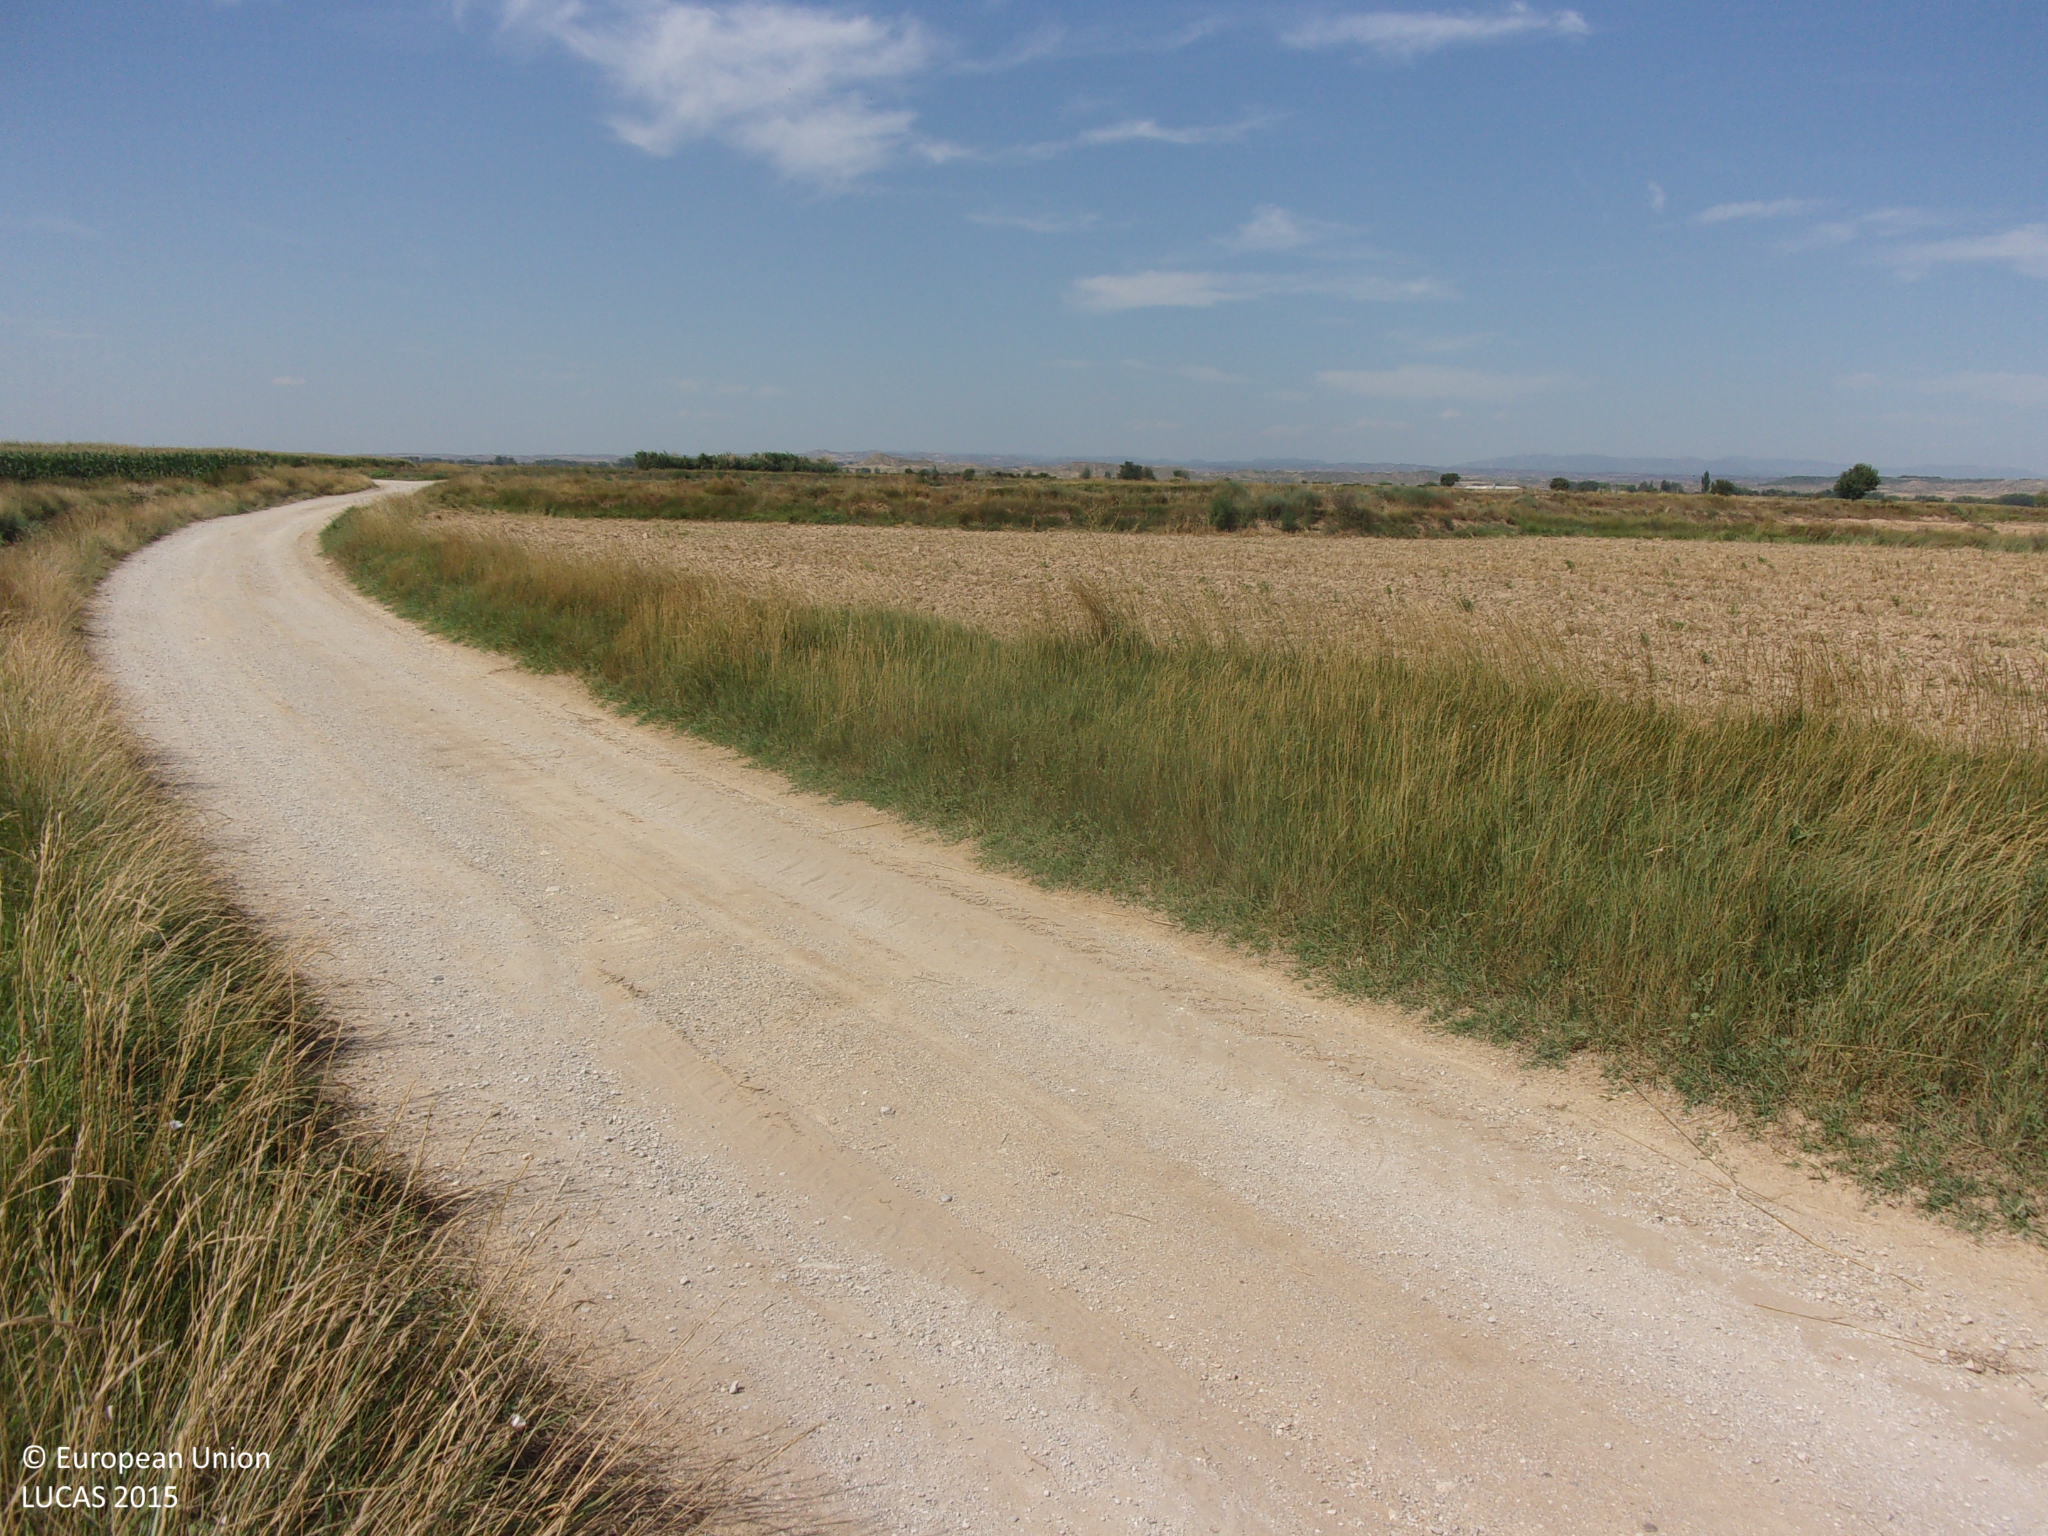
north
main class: Cropland
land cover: Barley
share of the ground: < 10 %
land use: Agriculture (excluding fallow land and kitchen gardens)
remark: Harvested field
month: August
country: ES
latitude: 42.1637
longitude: -1.1521
